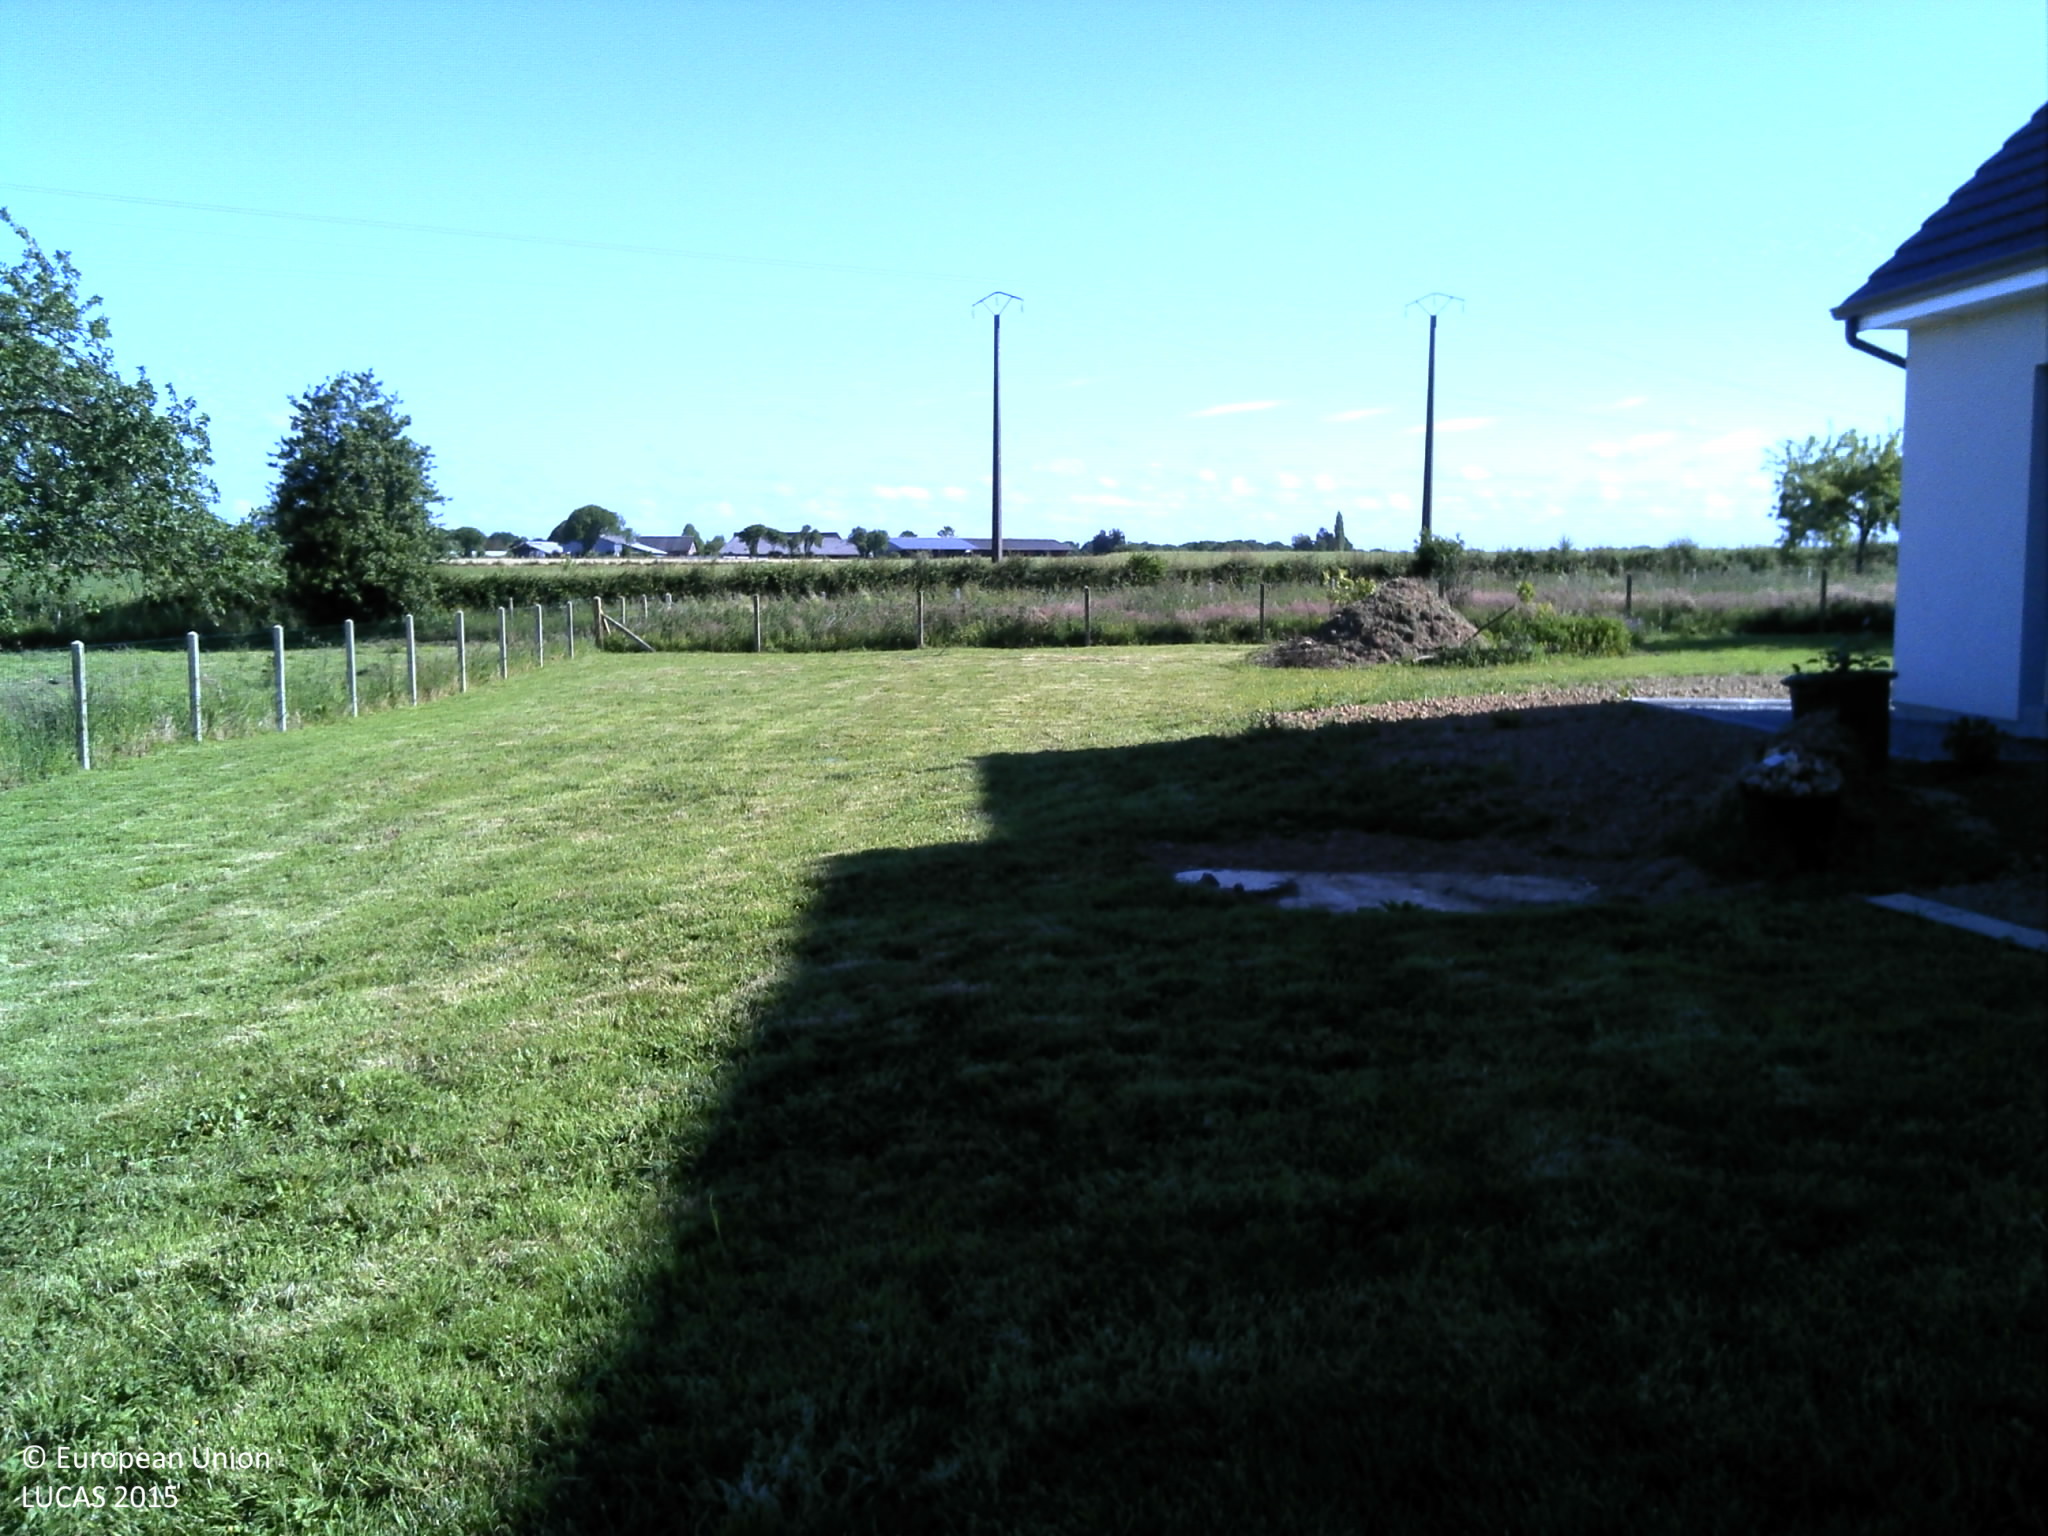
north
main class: Grassland
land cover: Grassland with sparse tree/shrub cover
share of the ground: > 75 %
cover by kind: herbaceous plants 95 %, broadleaved forest trees 5 %
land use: Residential
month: June
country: FR
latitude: 49.5833
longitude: 1.1125
